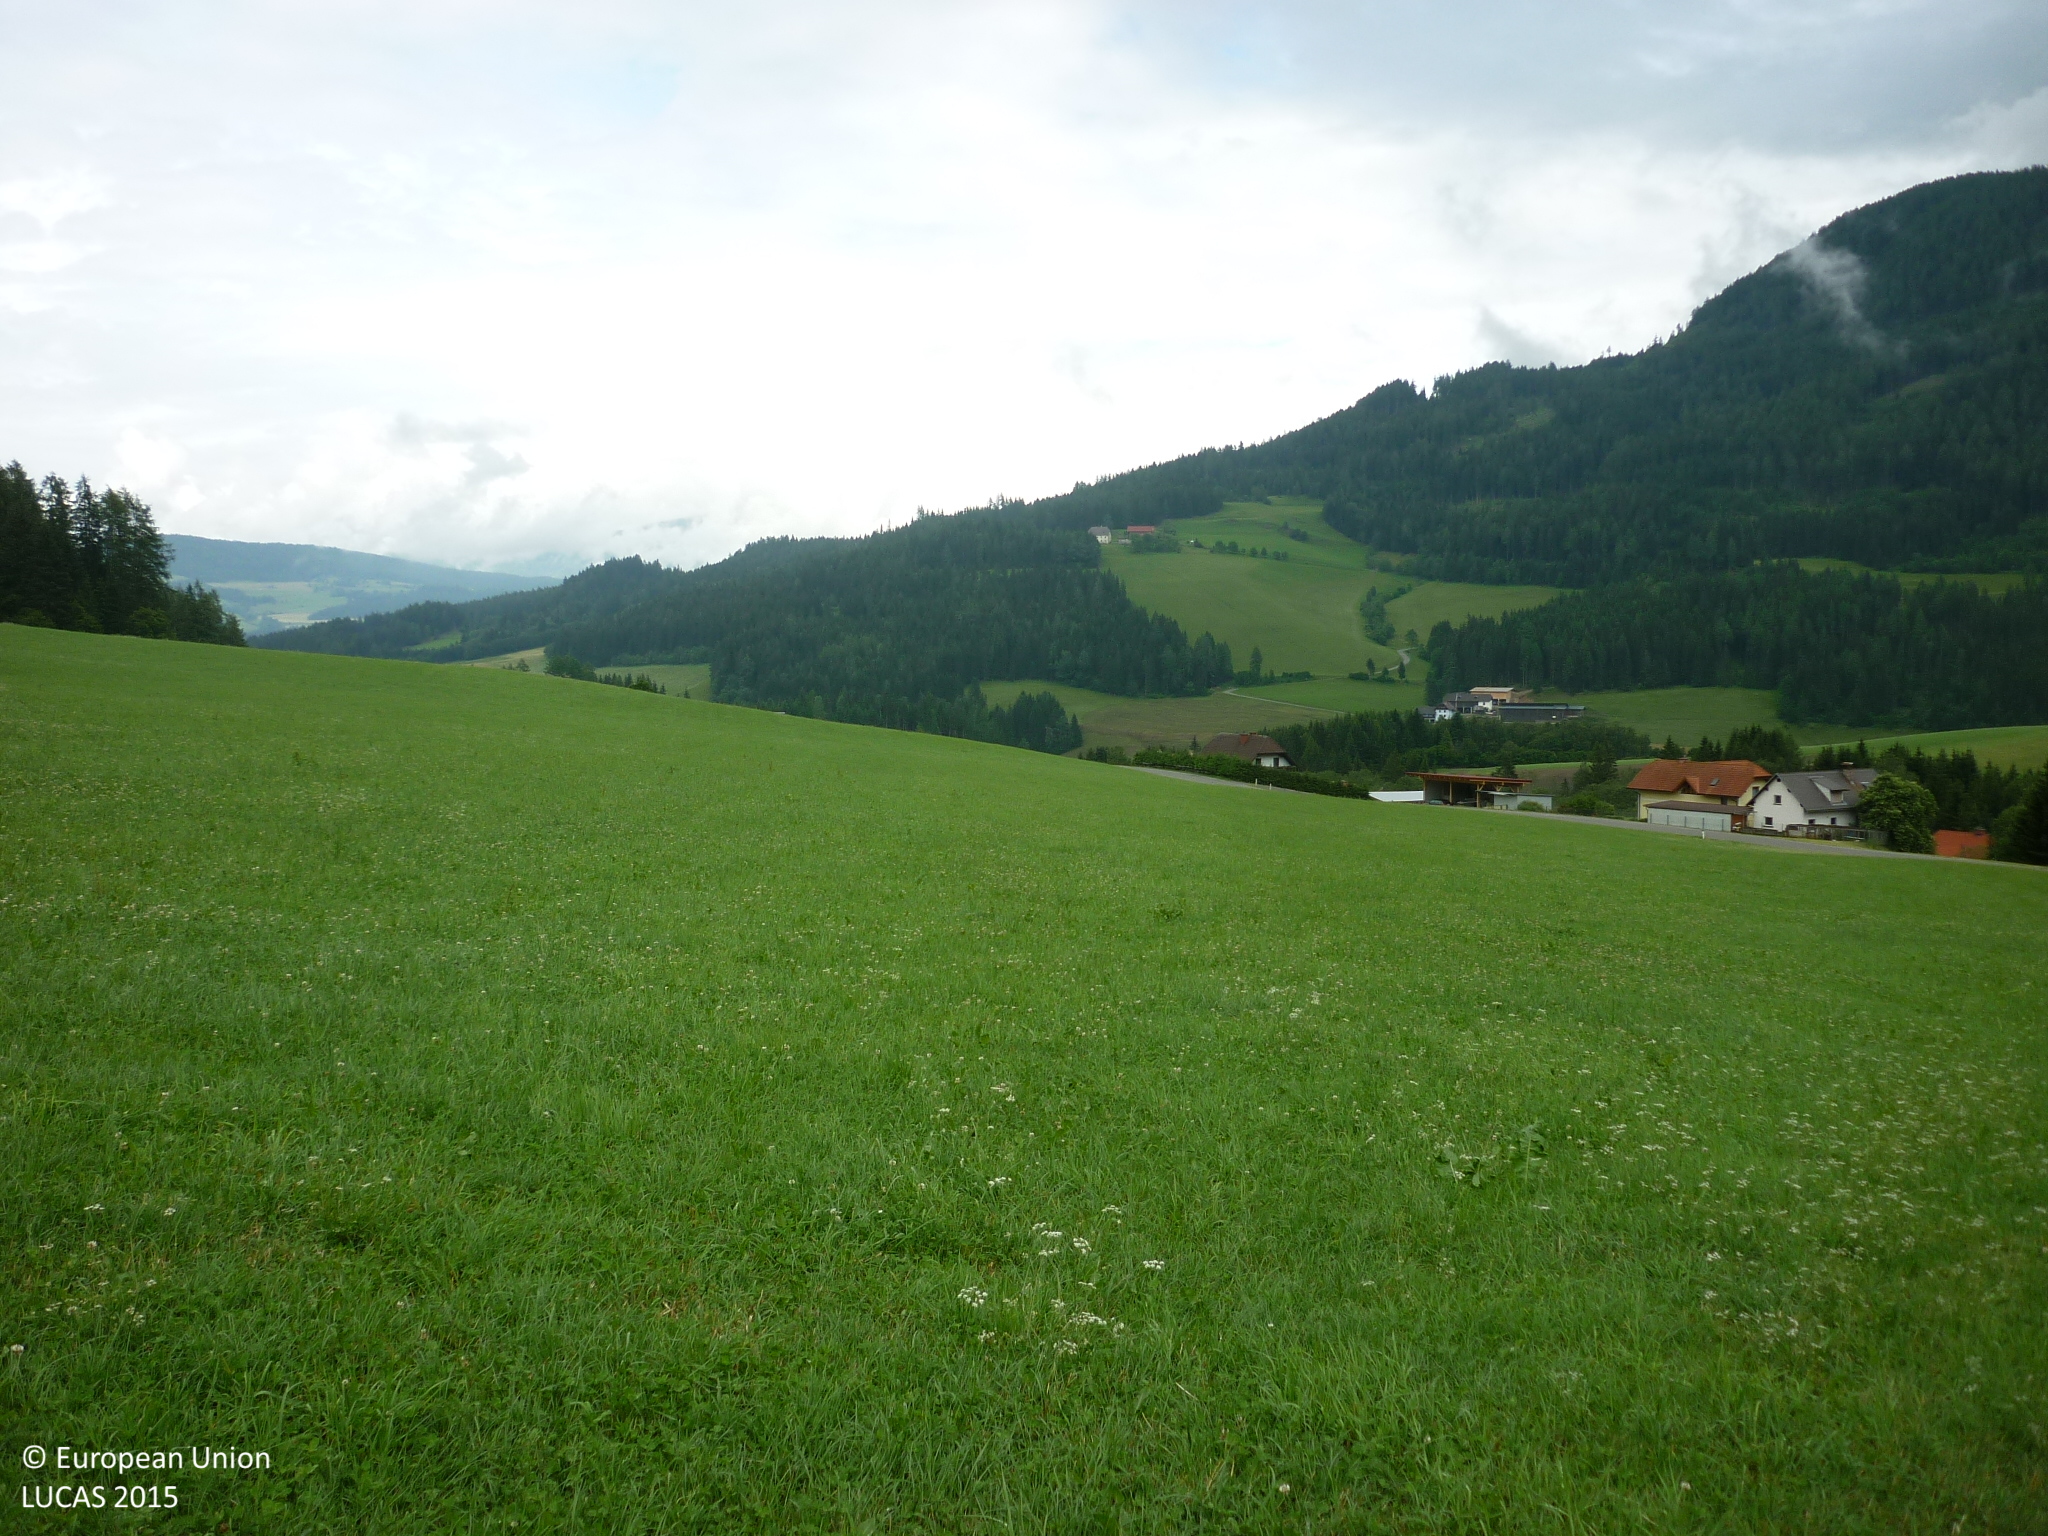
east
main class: Grassland
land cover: Grassland without tree/shrub cover
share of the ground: > 75 %
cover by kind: herbaceous plants 100 %
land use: Agriculture (excluding fallow land and kitchen gardens)
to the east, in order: Tracks; Grassland without tree/shrub cover
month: June
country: AT
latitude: 47.0940
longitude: 14.3063
